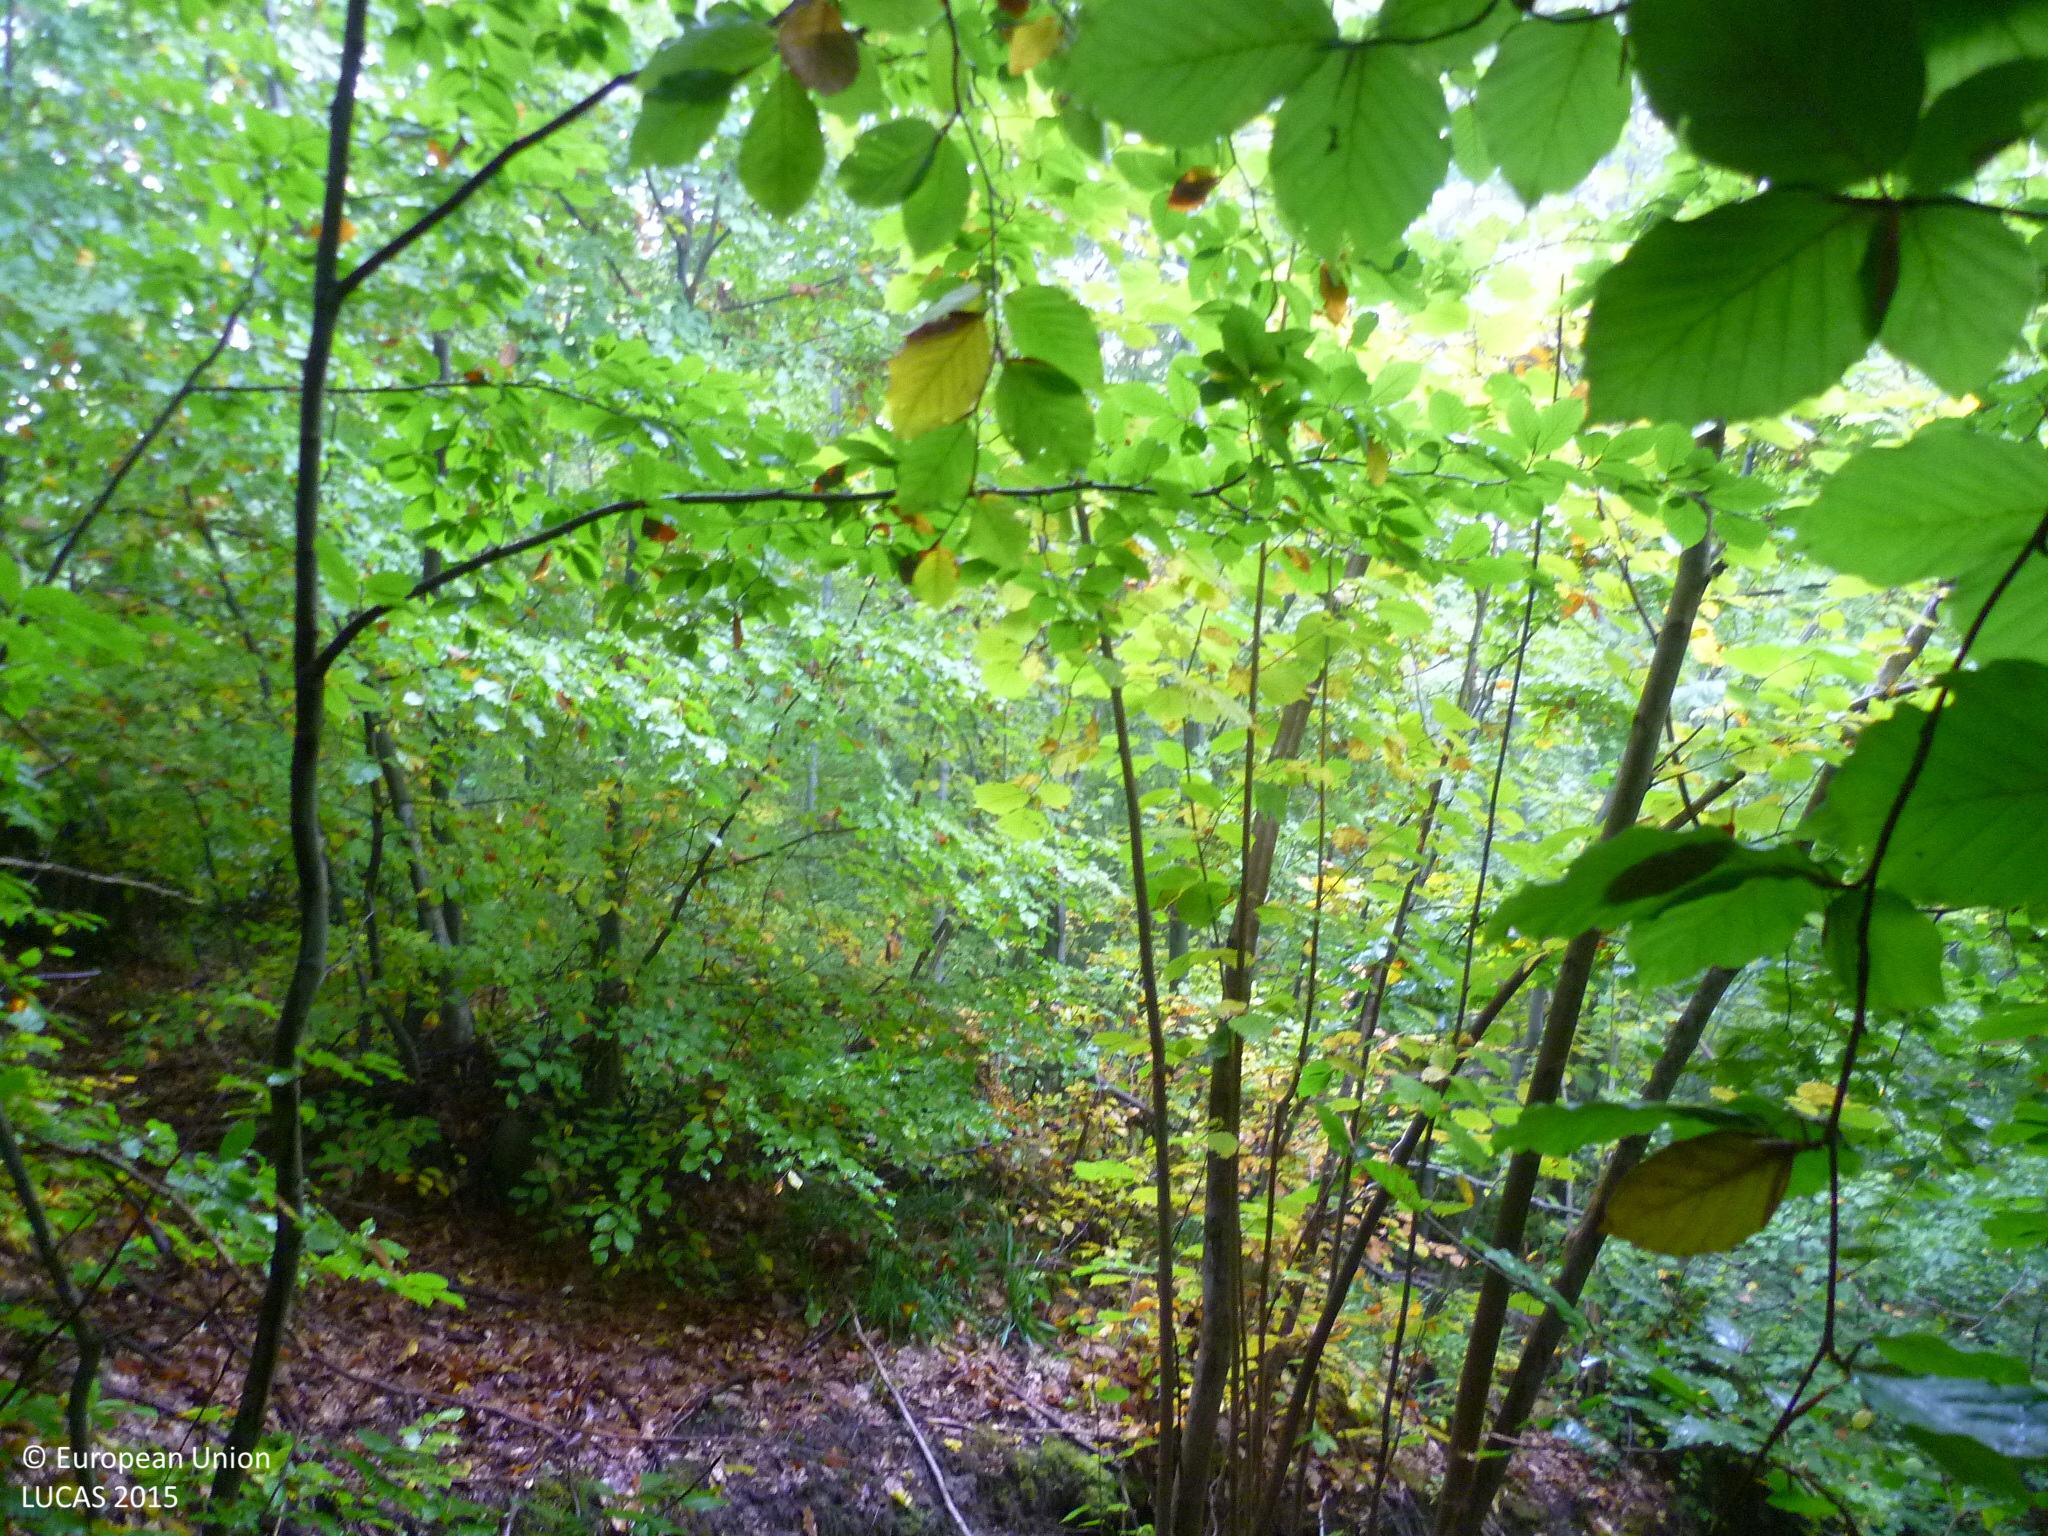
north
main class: Woodland
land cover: Broadleaved woodland
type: beech forest
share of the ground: > 75 %
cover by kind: broadleaved forest trees 80 %, unconsolidated bare surface 15 %, lichens and mosses 5 %
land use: Forestry
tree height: > 5 m
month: October
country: BG
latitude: 42.3543
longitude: 23.5956
